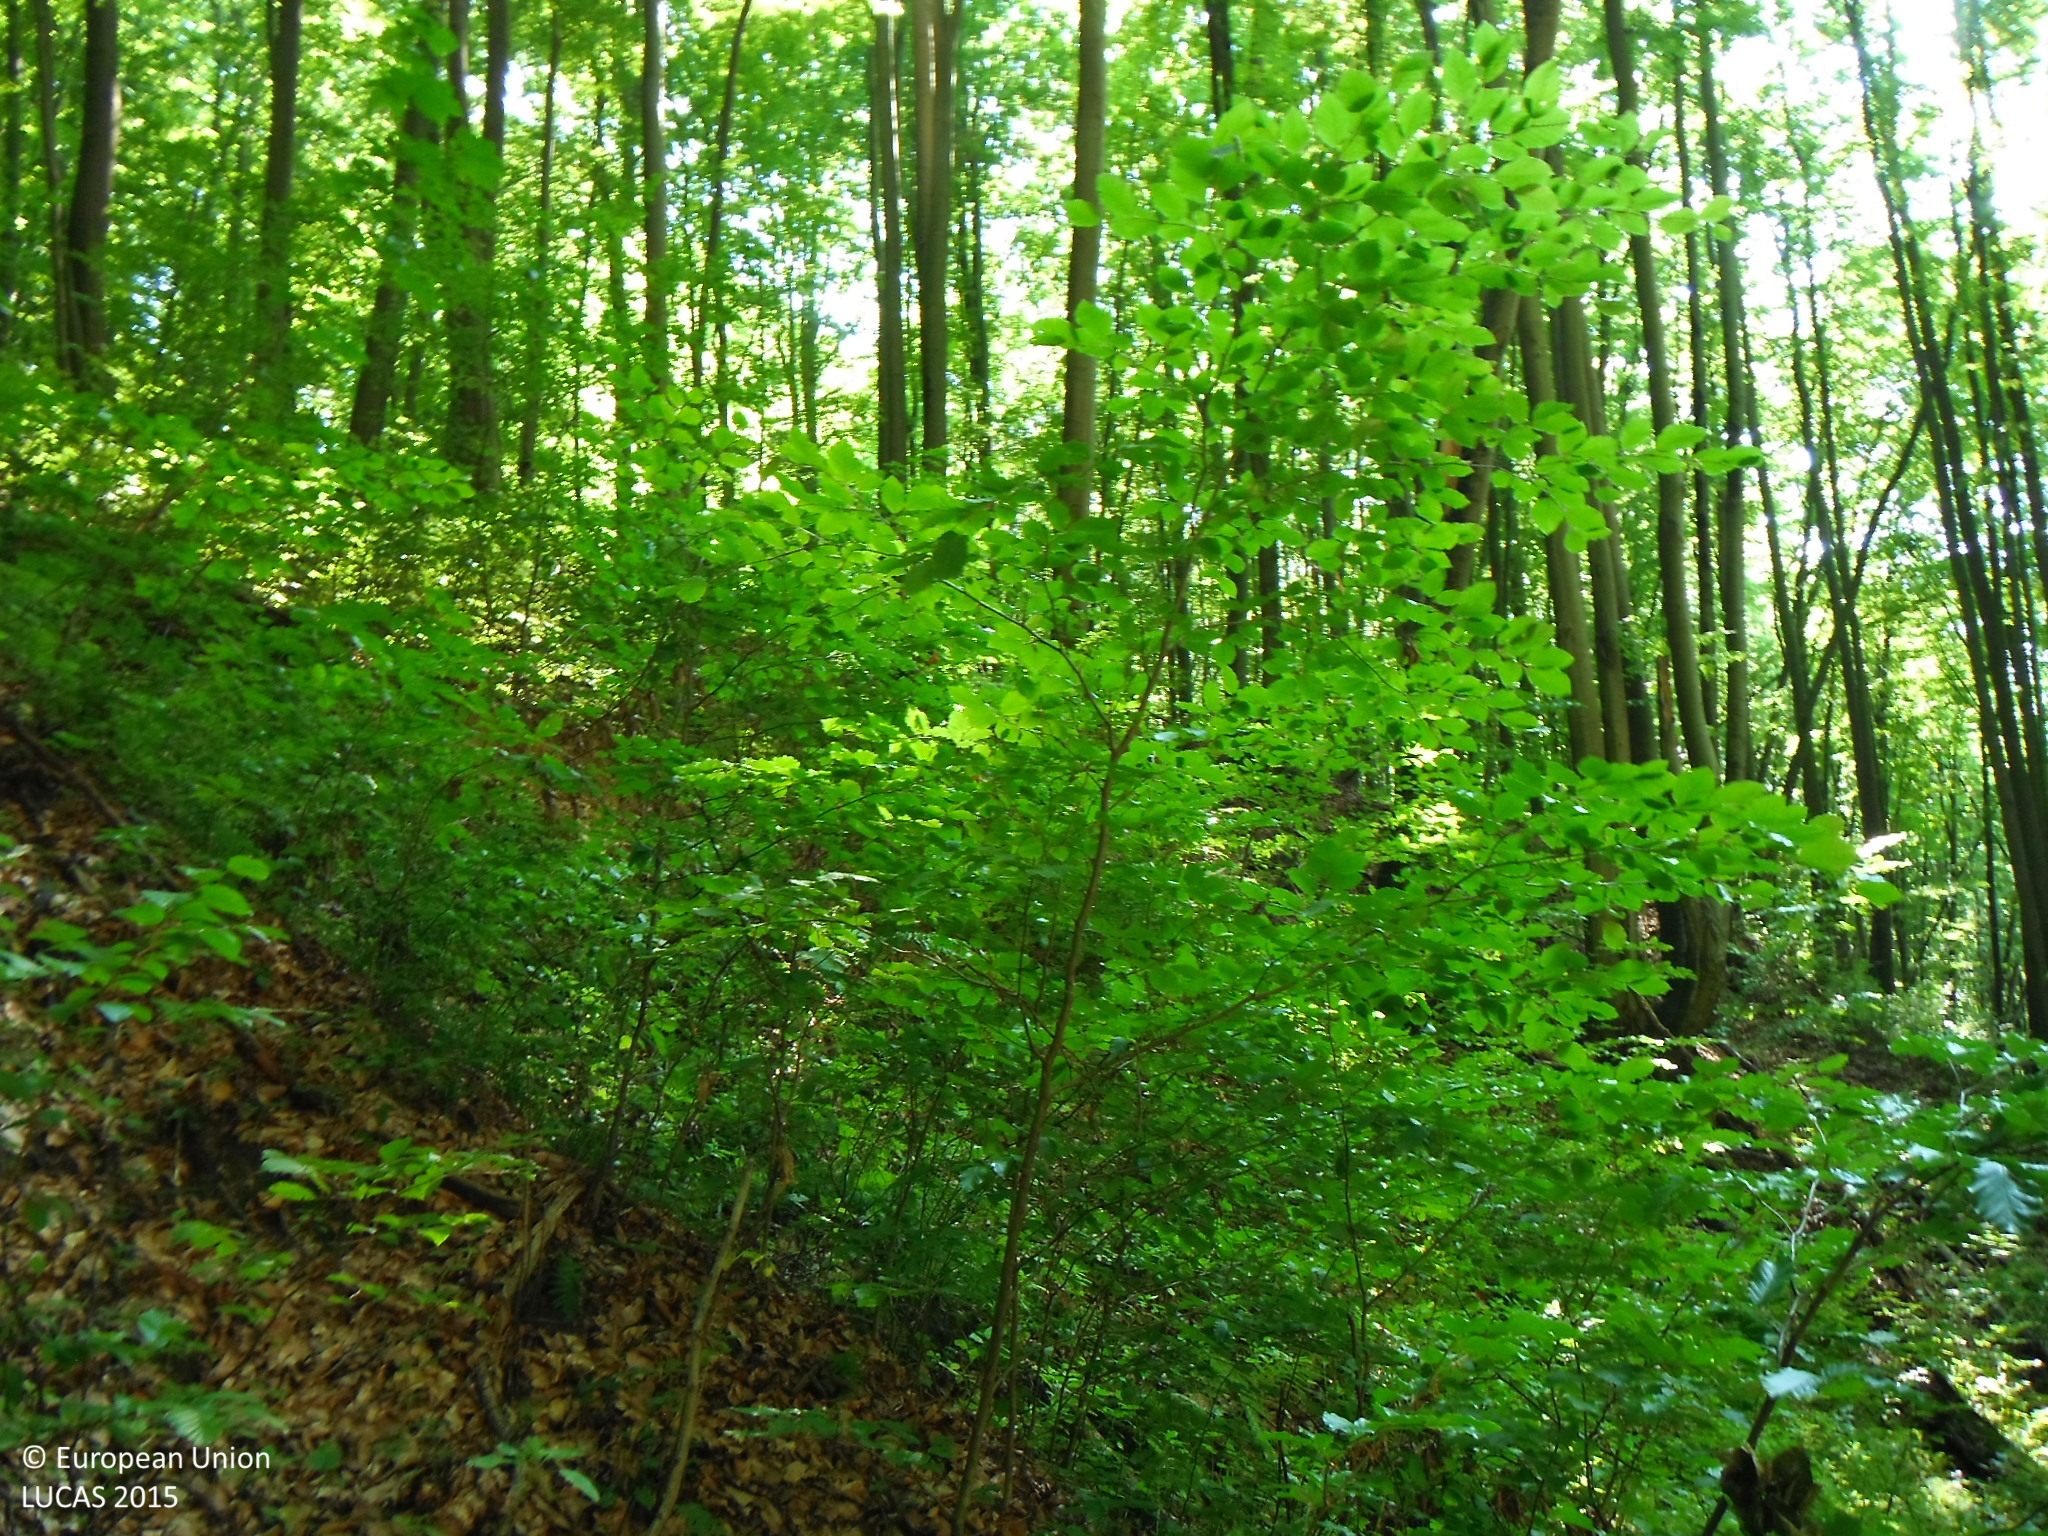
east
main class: Woodland
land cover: Broadleaved woodland
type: beech forest
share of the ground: > 75 %
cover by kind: broadleaved forest trees 90 %, herbaceous plants 10 %
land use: Forestry
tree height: > 5 m
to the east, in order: Broadleaved woodland; Rivers and streams; Broadleaved woodland; Tracks; Broadleaved woodland; Tracks; Broadleaved woodland; Ditches and canals; Broadleaved woodland
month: July
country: SK
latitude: 49.2612
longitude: 21.4395
